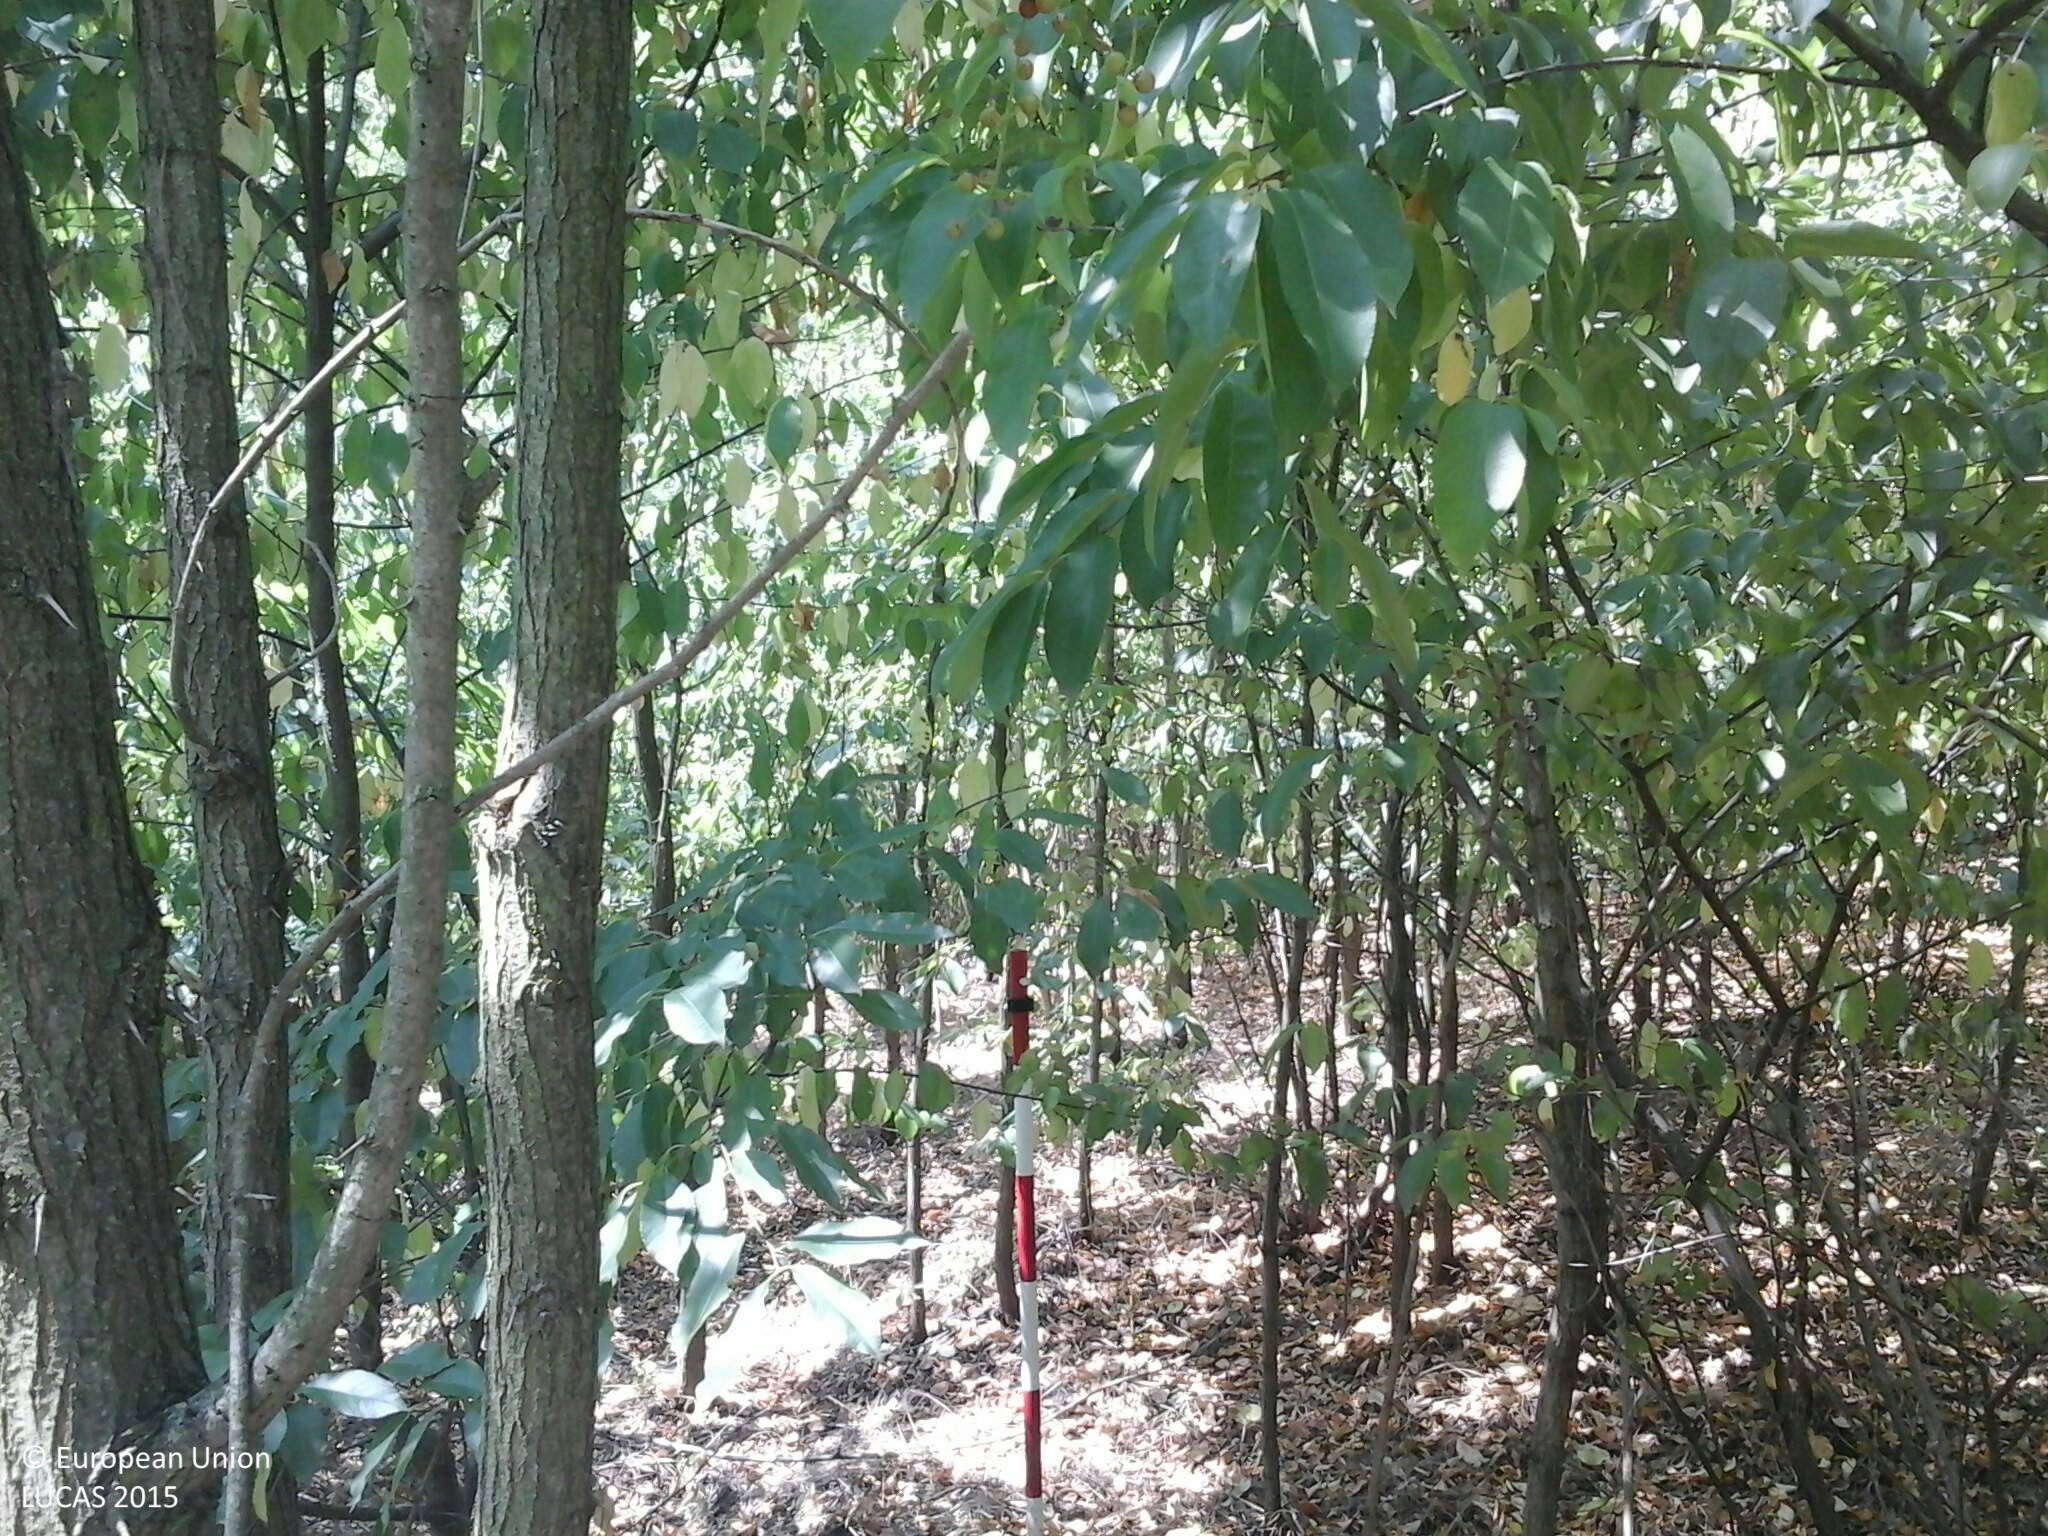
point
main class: Woodland
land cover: Broadleaved woodland
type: mesophytic deciduous forest
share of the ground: > 75 %
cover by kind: broadleaved forest trees 95 %, herbaceous plants 5 %
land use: Forestry
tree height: > 5 m
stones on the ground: < 10 %
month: July
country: HU
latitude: 47.7663
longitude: 22.3175
